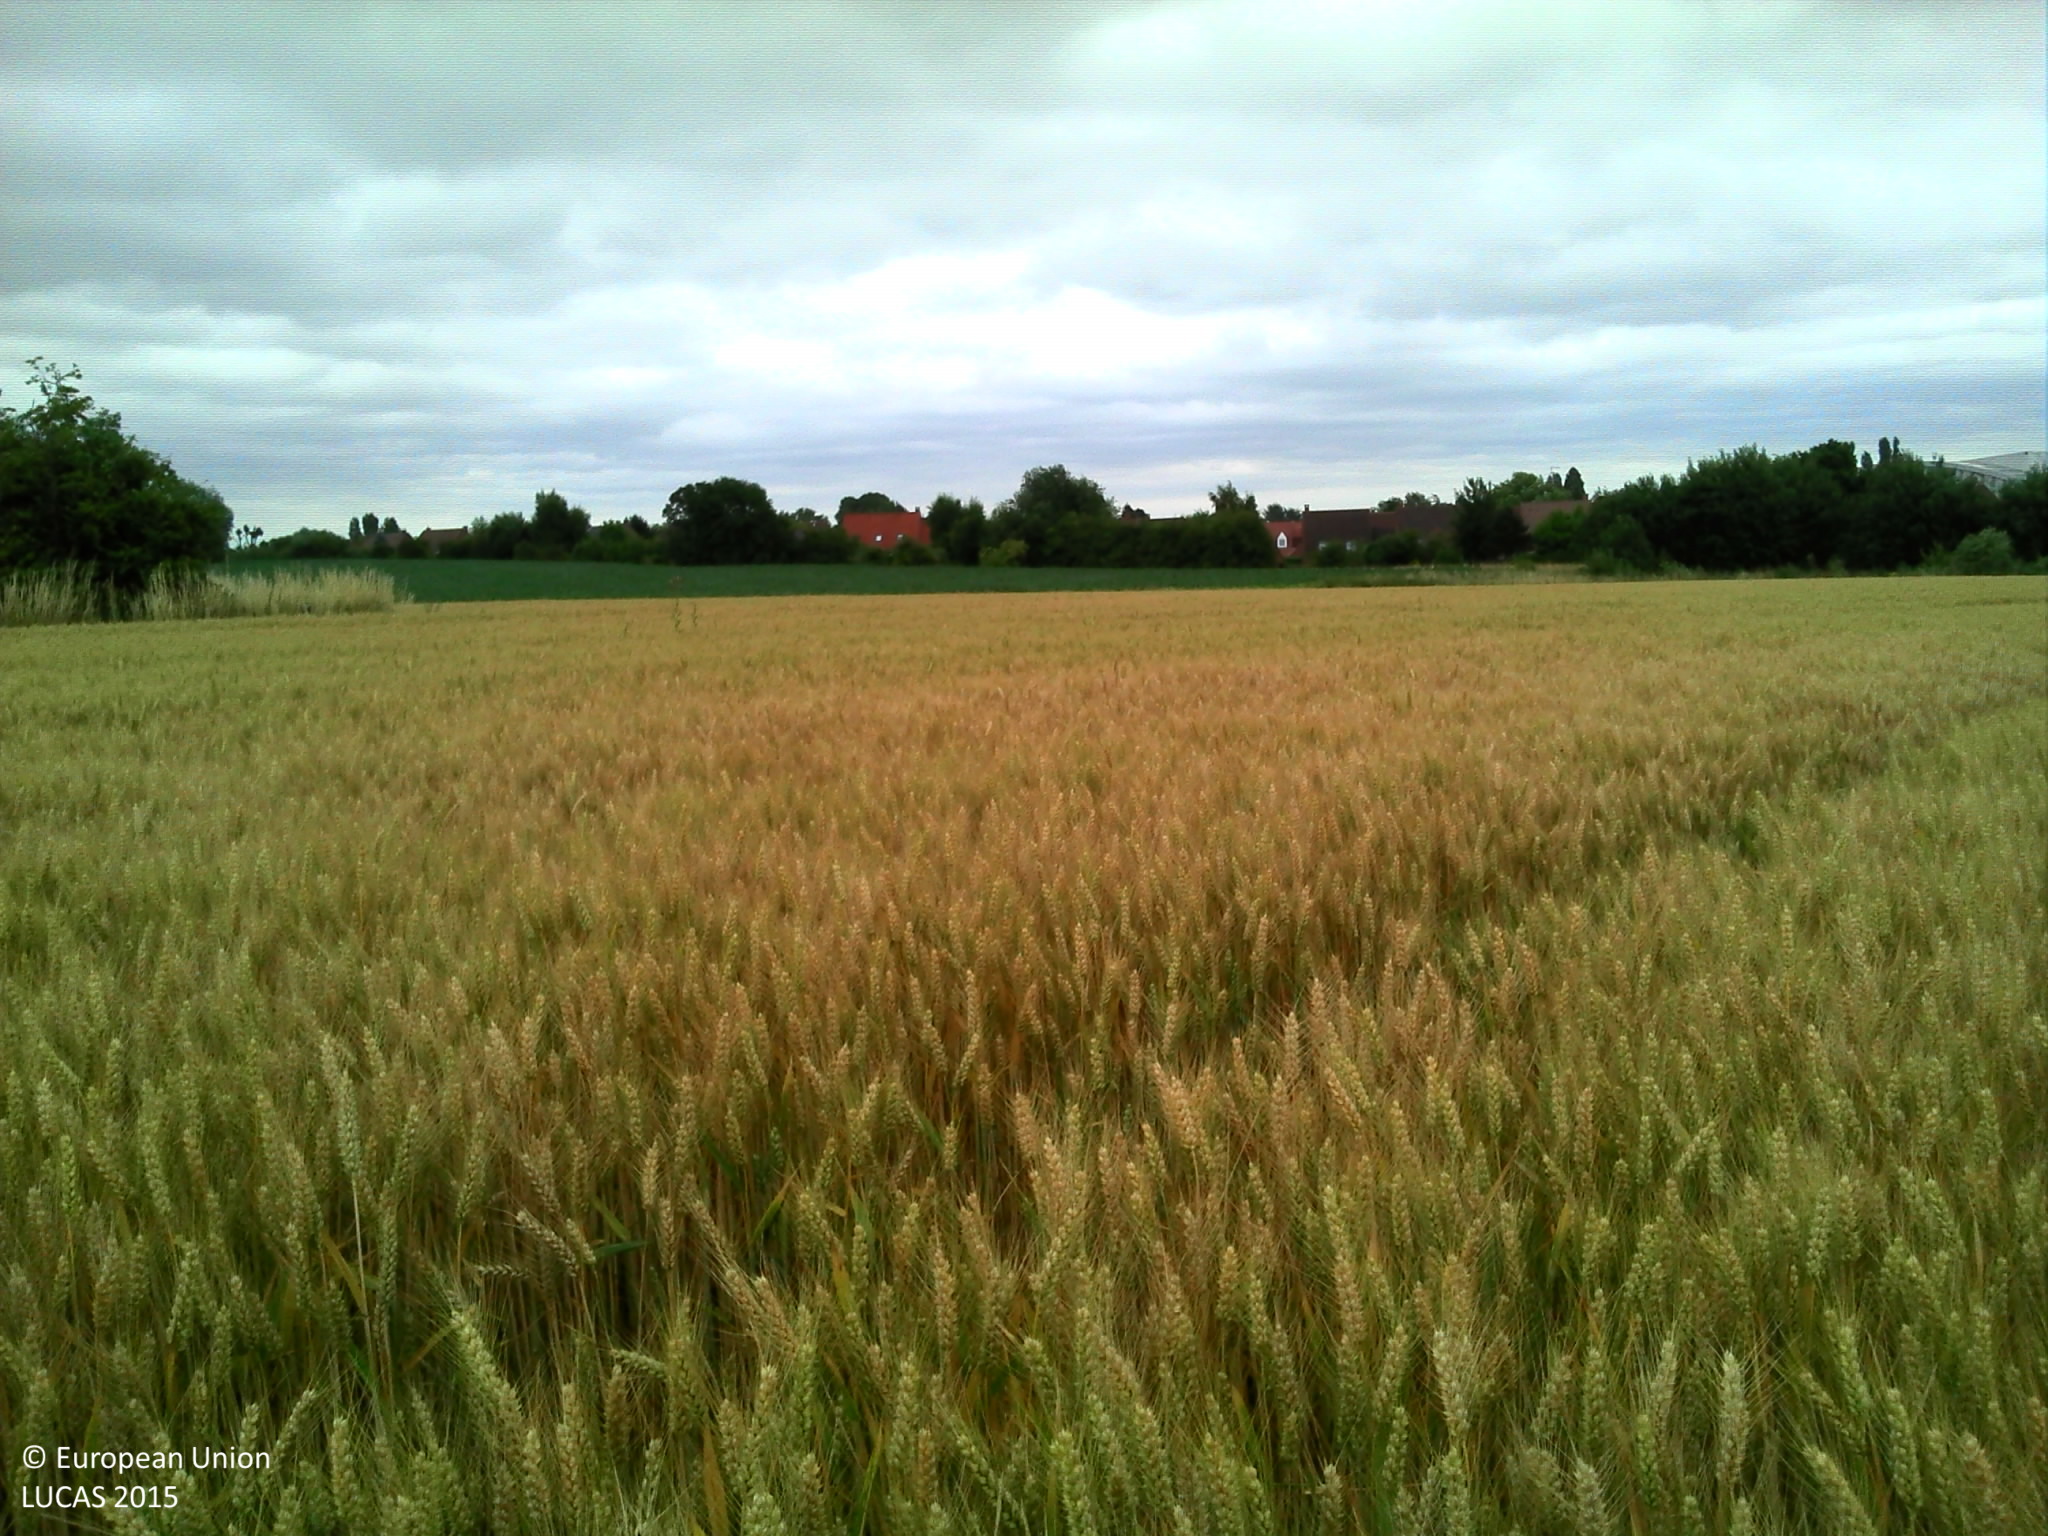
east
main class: Cropland
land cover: Common wheat
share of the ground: > 75 %
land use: Agriculture (excluding fallow land and kitchen gardens)
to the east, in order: Common wheat; Grass margins; Ditches and canals; Grass margins; Maize; Broadleaved woodland; Tracks; Fences; Broadleaved woodland; Artificial constructions in urban areas
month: July
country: FR
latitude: 50.7700
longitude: 3.1134
